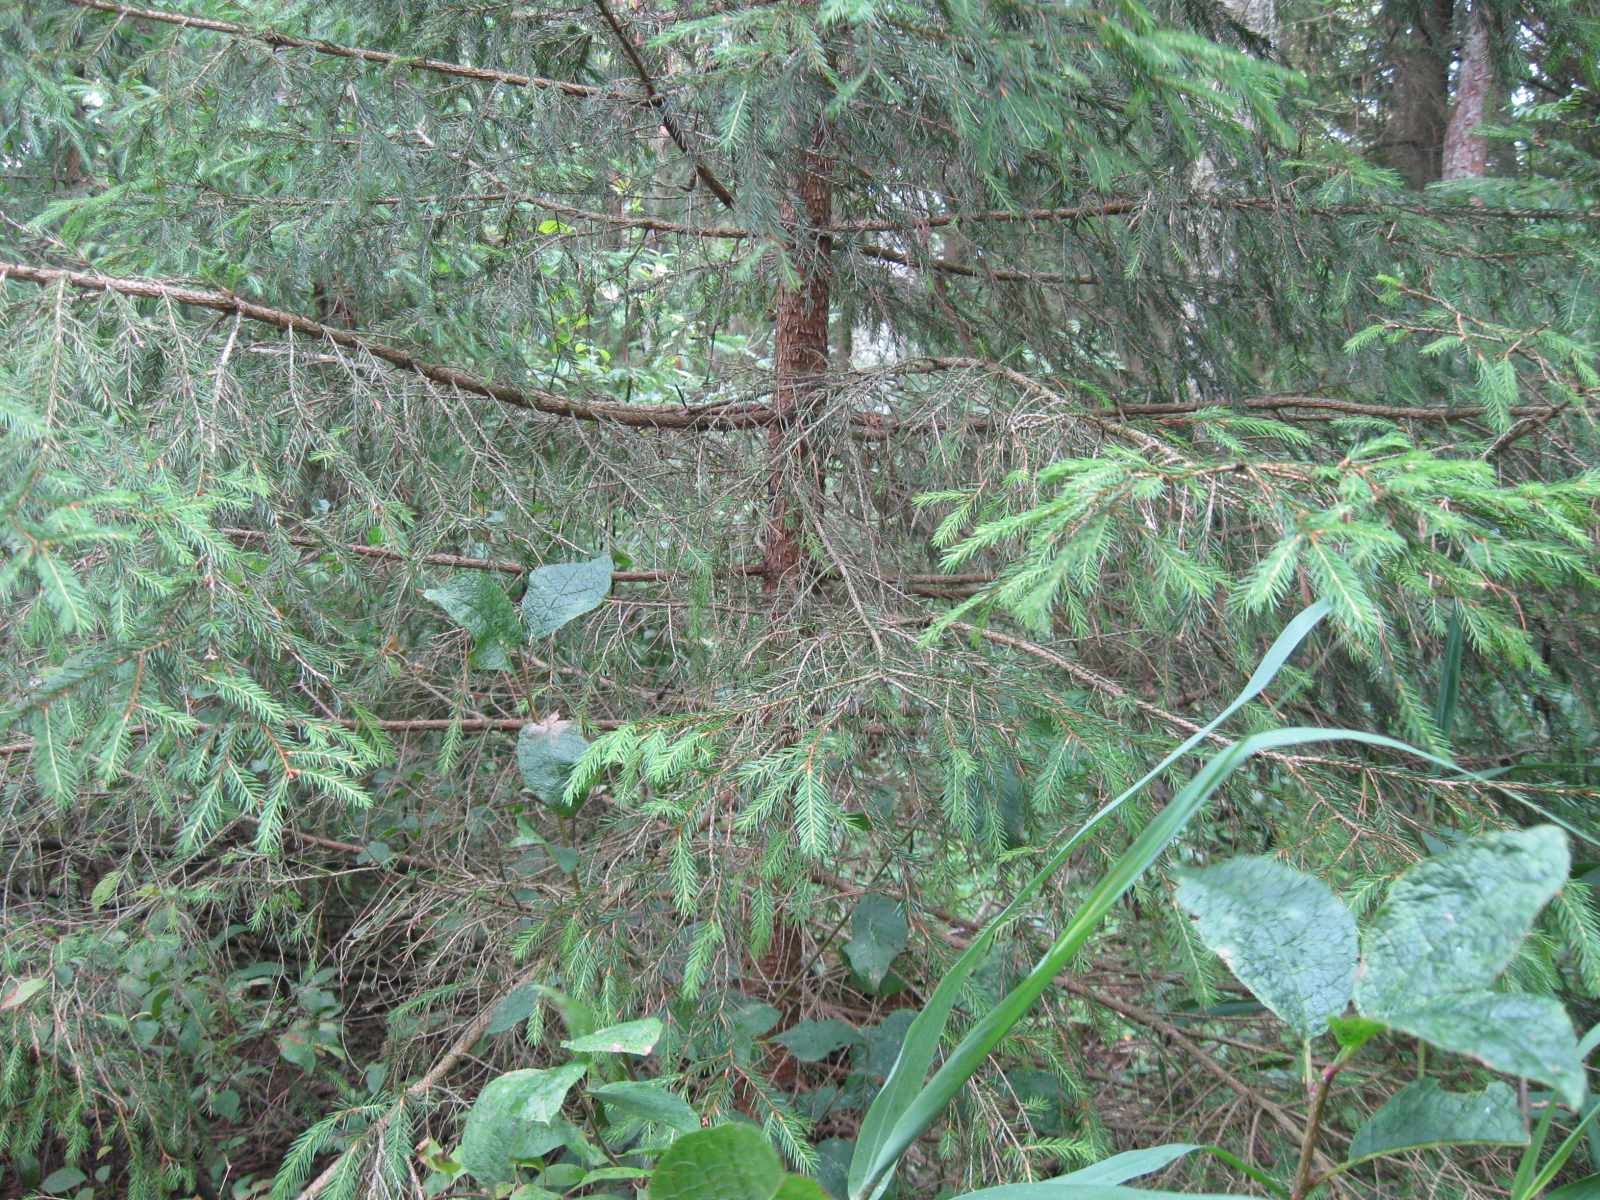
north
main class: Woodland
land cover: Other mixed woodland
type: mire and swamp forests
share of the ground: > 75 %
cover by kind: broadleaved forest trees 50 %, coniferous forest trees 35 %, shrubs 10 %, herbaceous plants 5 %
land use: Forestry
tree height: > 5 m
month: July
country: LT
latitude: 54.2969
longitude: 24.3435
